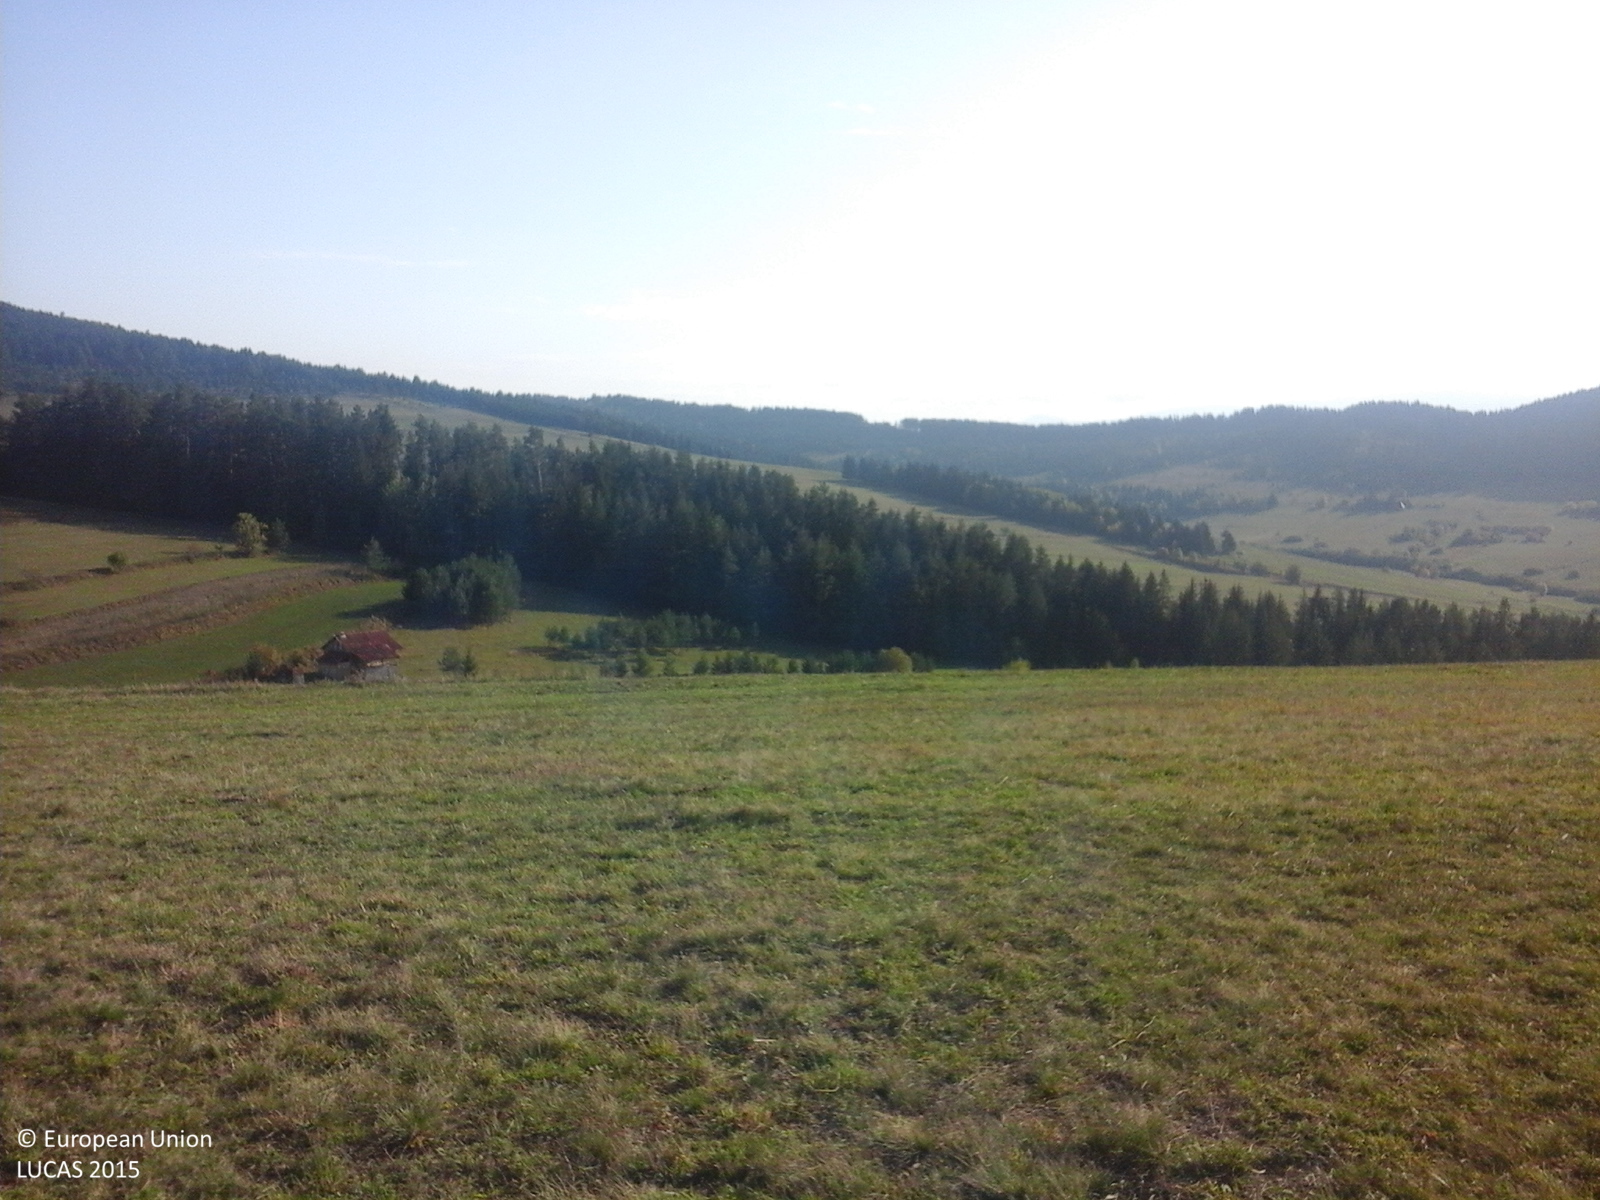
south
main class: Grassland
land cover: Grassland without tree/shrub cover
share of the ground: > 75 %
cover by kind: herbaceous plants 100 %
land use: Agriculture (excluding fallow land and kitchen gardens)
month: October
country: RO
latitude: 46.3867
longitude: 25.8637
